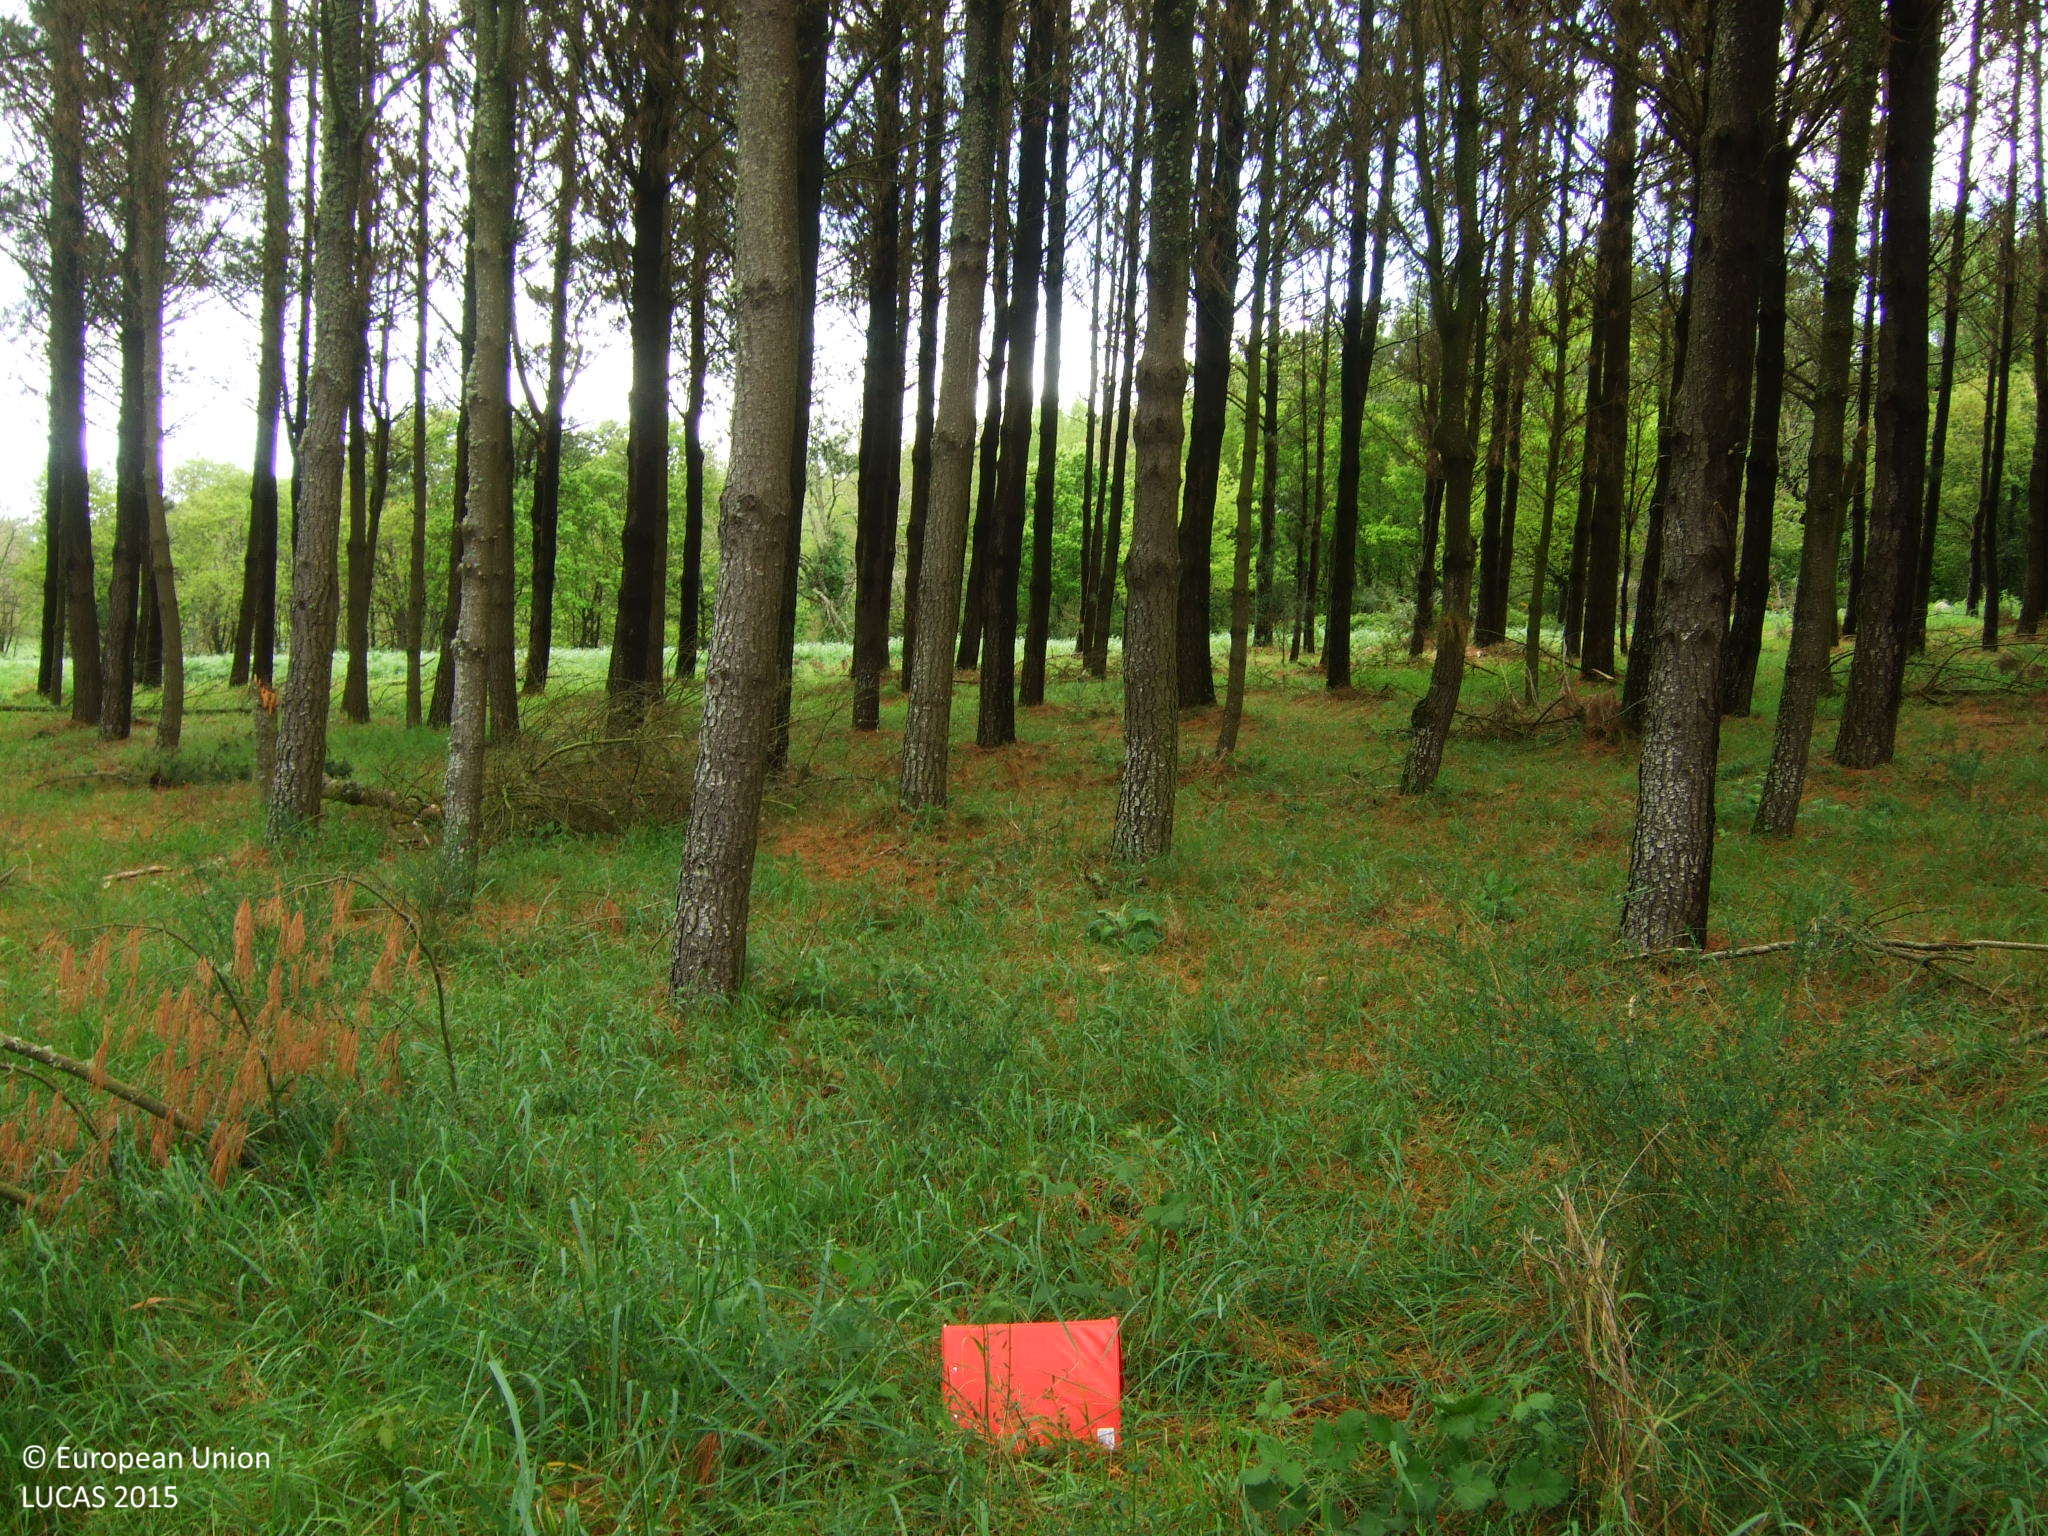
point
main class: Woodland
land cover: Pine dominated coniferous woodland
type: exotic forest
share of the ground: 50 - 75 %
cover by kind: coniferous forest trees 65 %, herbaceous plants 25 %, shrubs 5 %, unconsolidated bare surface 5 %
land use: Forestry
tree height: > 5 m
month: May
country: ES
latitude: 42.7906
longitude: -7.5189
